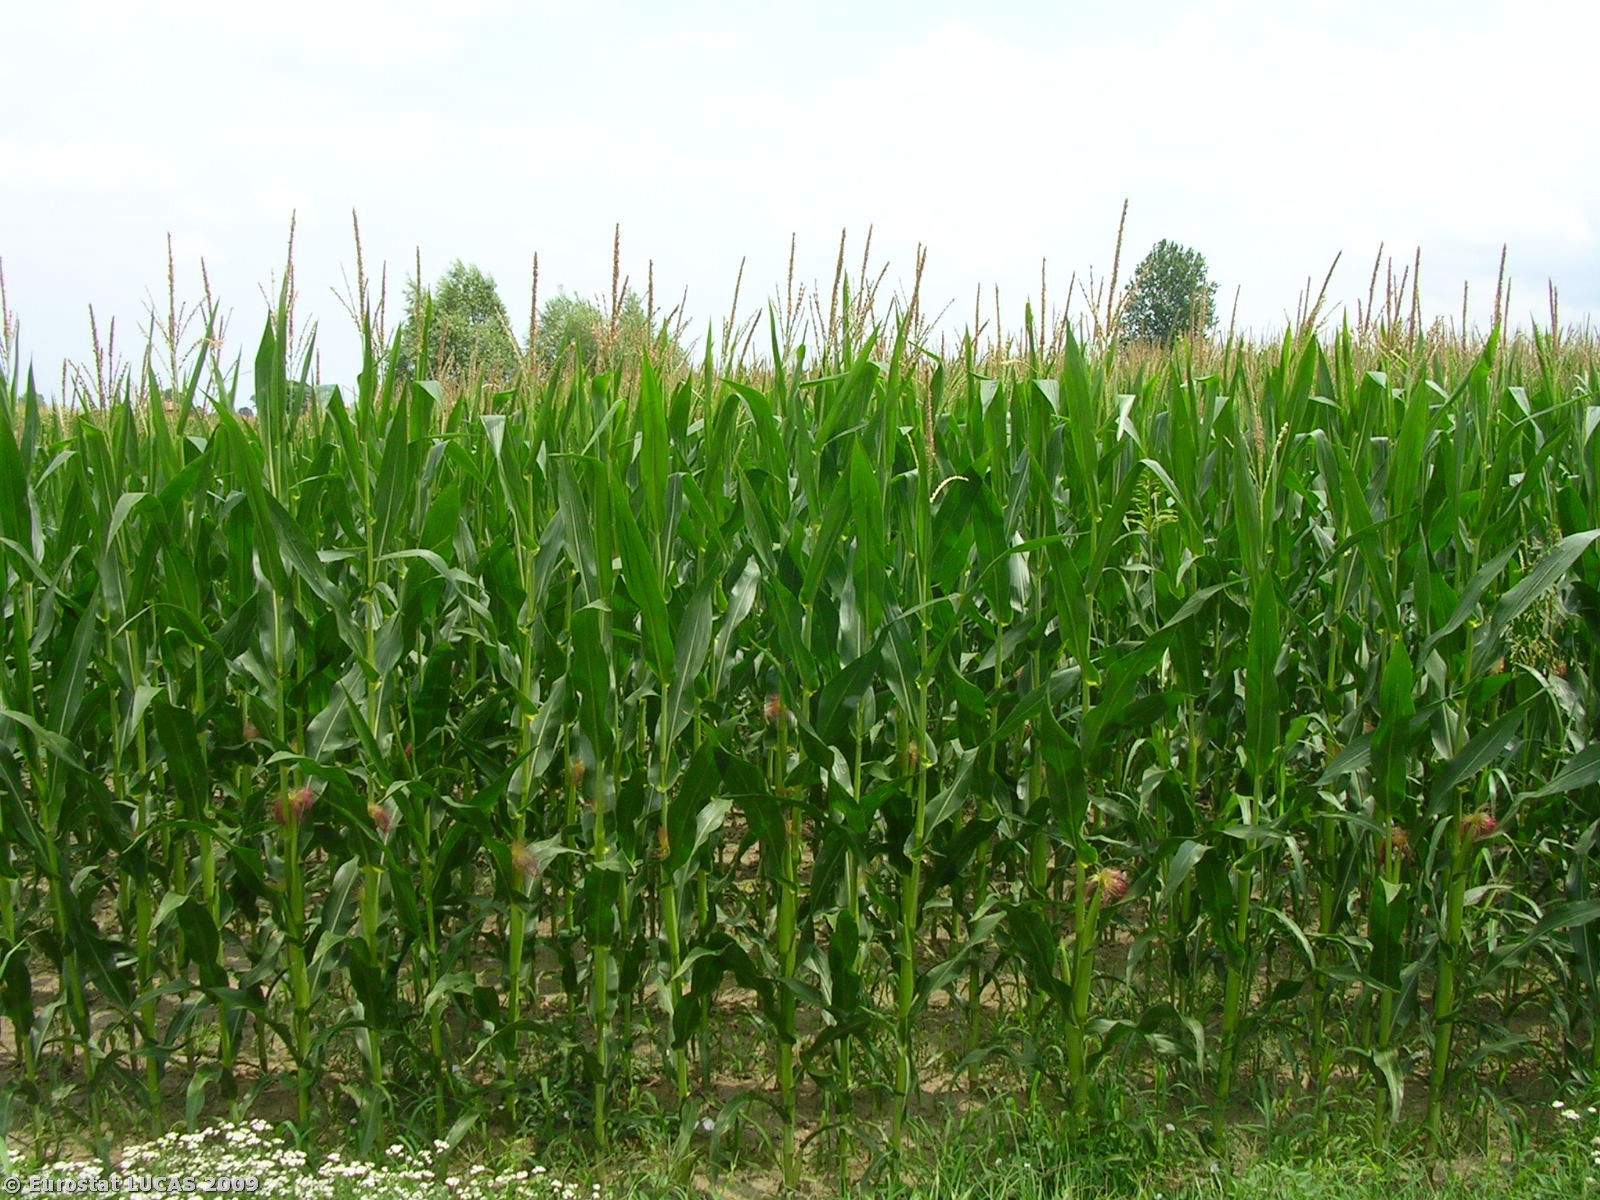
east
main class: Cropland
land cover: Maize
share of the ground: > 75 %
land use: Agriculture (excluding fallow land and kitchen gardens)
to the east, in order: Maize; Electric lines; Grass margins; Ditches and canals; Grass margins; Paved roads, cycling and walking lanes; Grass margins; Maize; Grassland without tree/shrub cover; Grass margins; Grassland without tree/shrub cover; Grass margins; Common wheat; Lines of trees; Grass margins; Ditches and canals; Grass margins; Maize; Grass margins; Ditches and canals; Grass margins; Maize
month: July
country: IT
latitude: 45.2317
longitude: 12.0726
